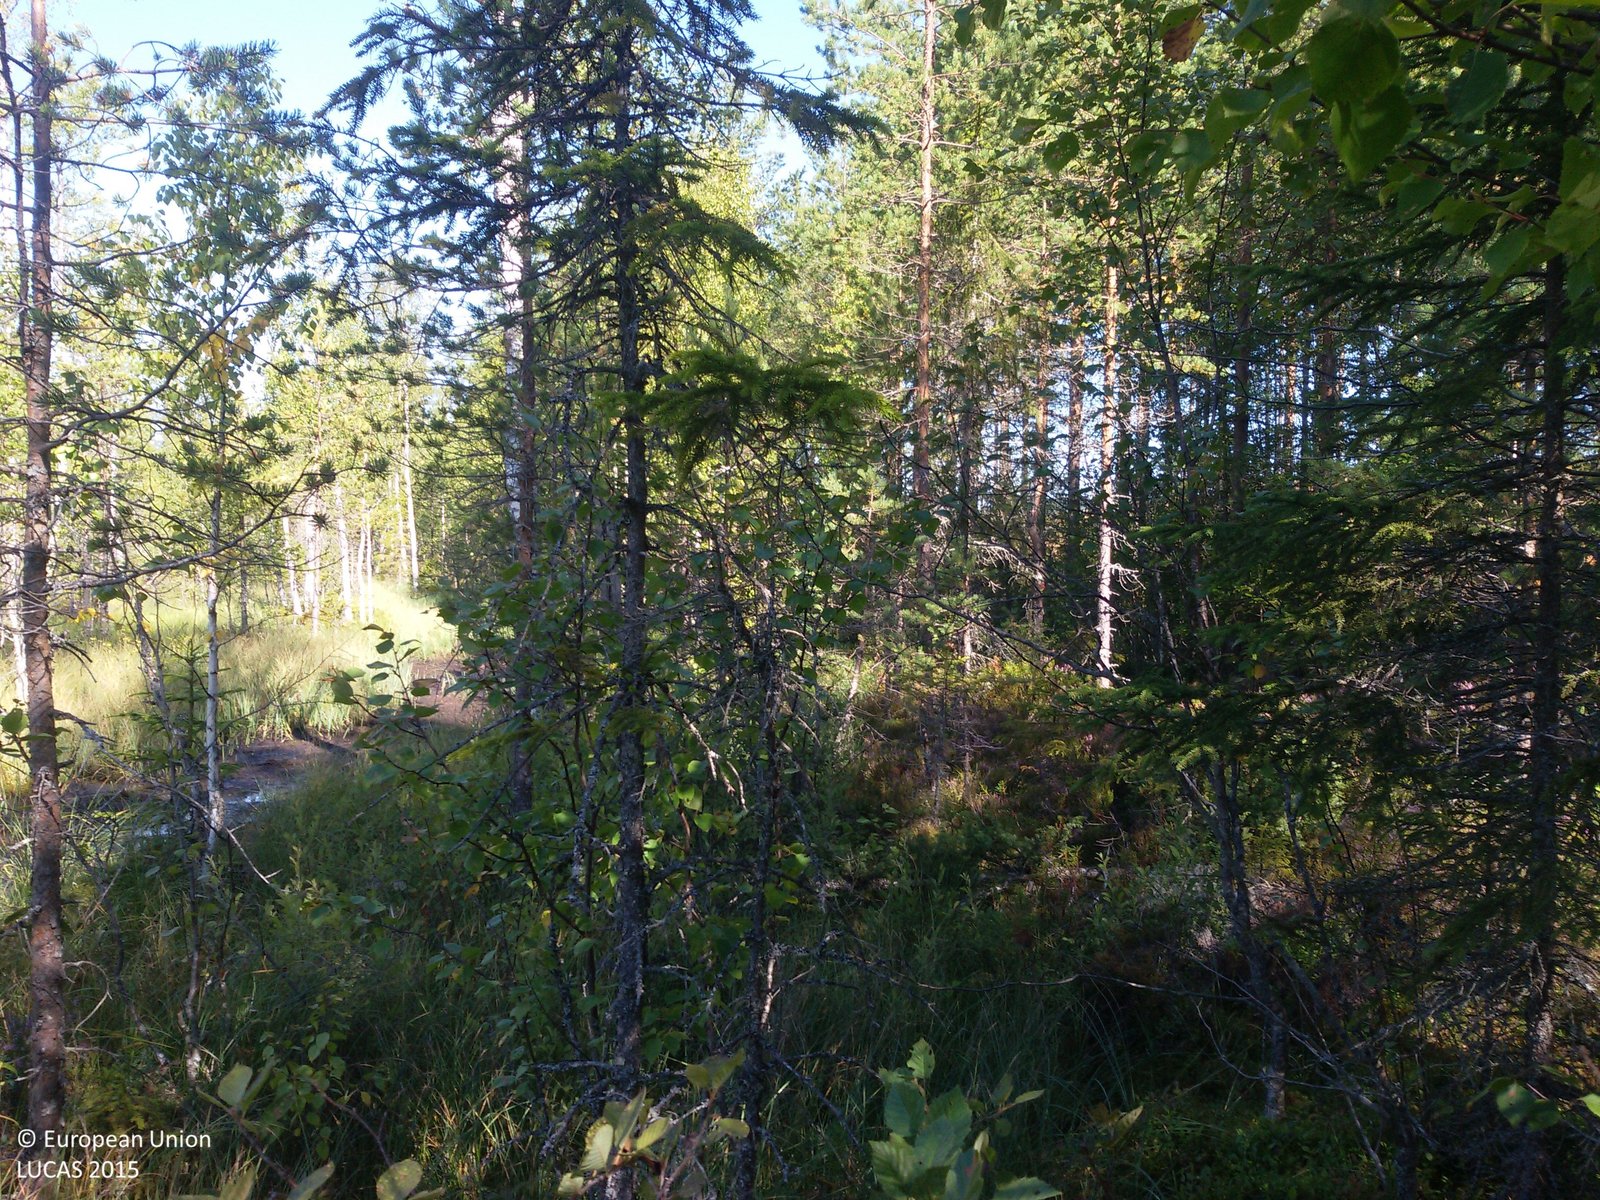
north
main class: Woodland
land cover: Pine dominated coniferous woodland
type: boreal forest
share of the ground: 50 - 75 %
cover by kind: coniferous forest trees 45 %, herbaceous plants 20 %, lichens and mosses 20 %, broadleaved forest trees 15 %
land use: Forestry
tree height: > 5 m
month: August
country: SE
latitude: 60.6340
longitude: 15.9287
